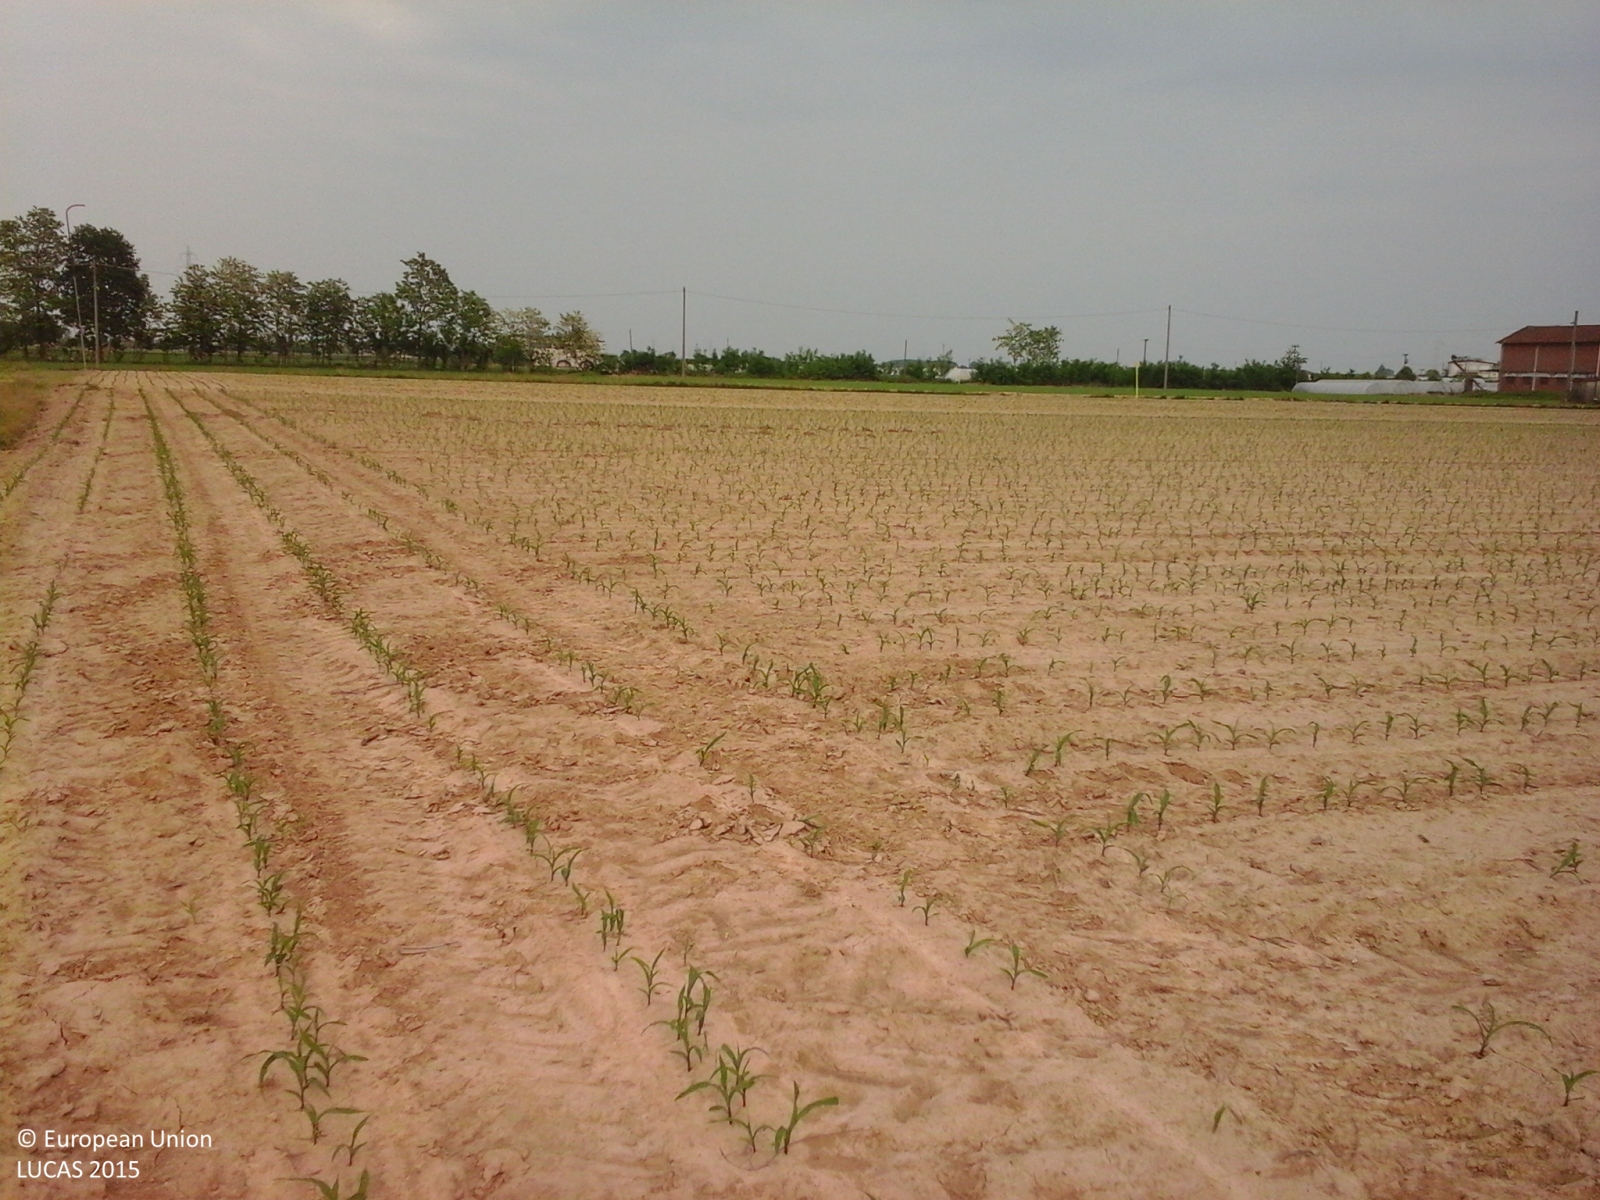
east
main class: Cropland
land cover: Maize
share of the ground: < 10 %
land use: Agriculture (excluding fallow land and kitchen gardens)
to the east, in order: Maize; Electric lines; Maize; Grass margins; Paved roads, cycling and walking lanes; Grass margins; Maize; Electric lines; Maize; Soya; Managed hedges; Electric lines; Ditches and canals; Managed hedges; Grass margins; Maize
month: May
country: IT
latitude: 44.8671
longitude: 7.7387
